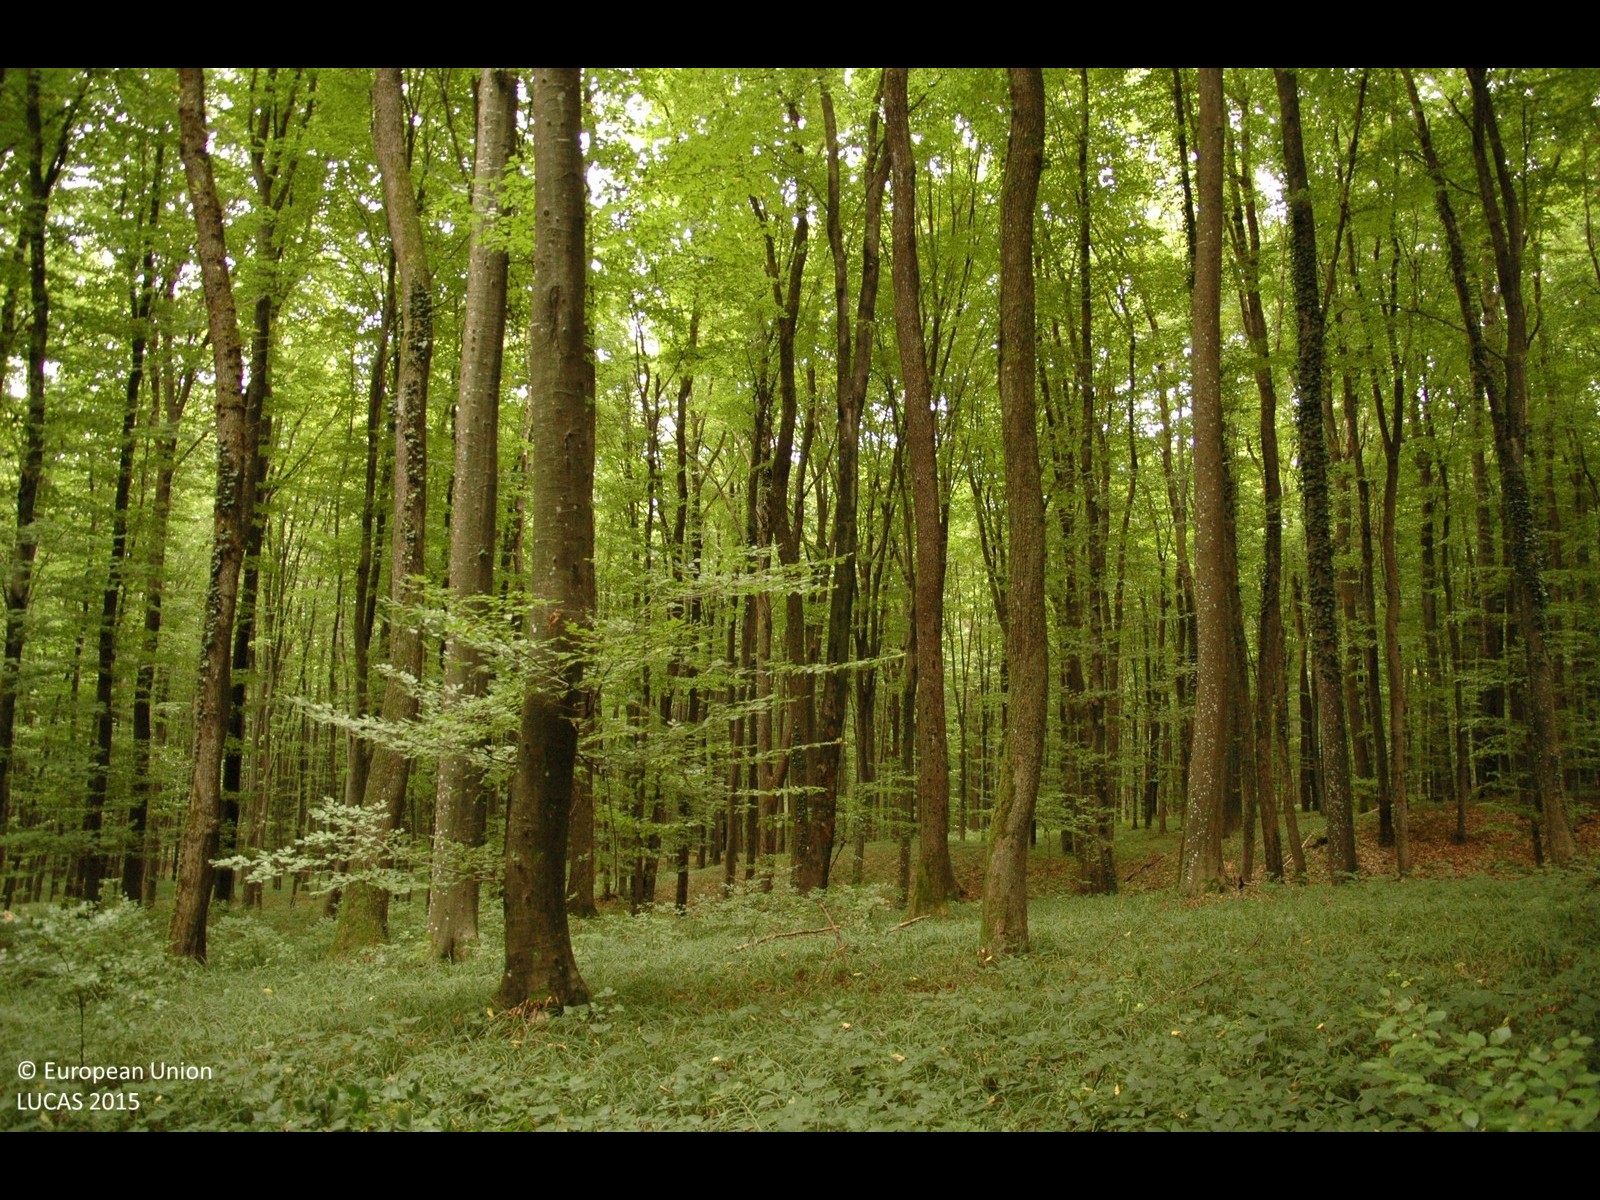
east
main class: Woodland
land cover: Broadleaved woodland
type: mesophytic deciduous forest
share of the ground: > 75 %
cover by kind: broadleaved forest trees 100 %
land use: Forestry
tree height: > 5 m
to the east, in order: Broadleaved woodland
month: September
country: HR
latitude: 46.0681
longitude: 16.7103
